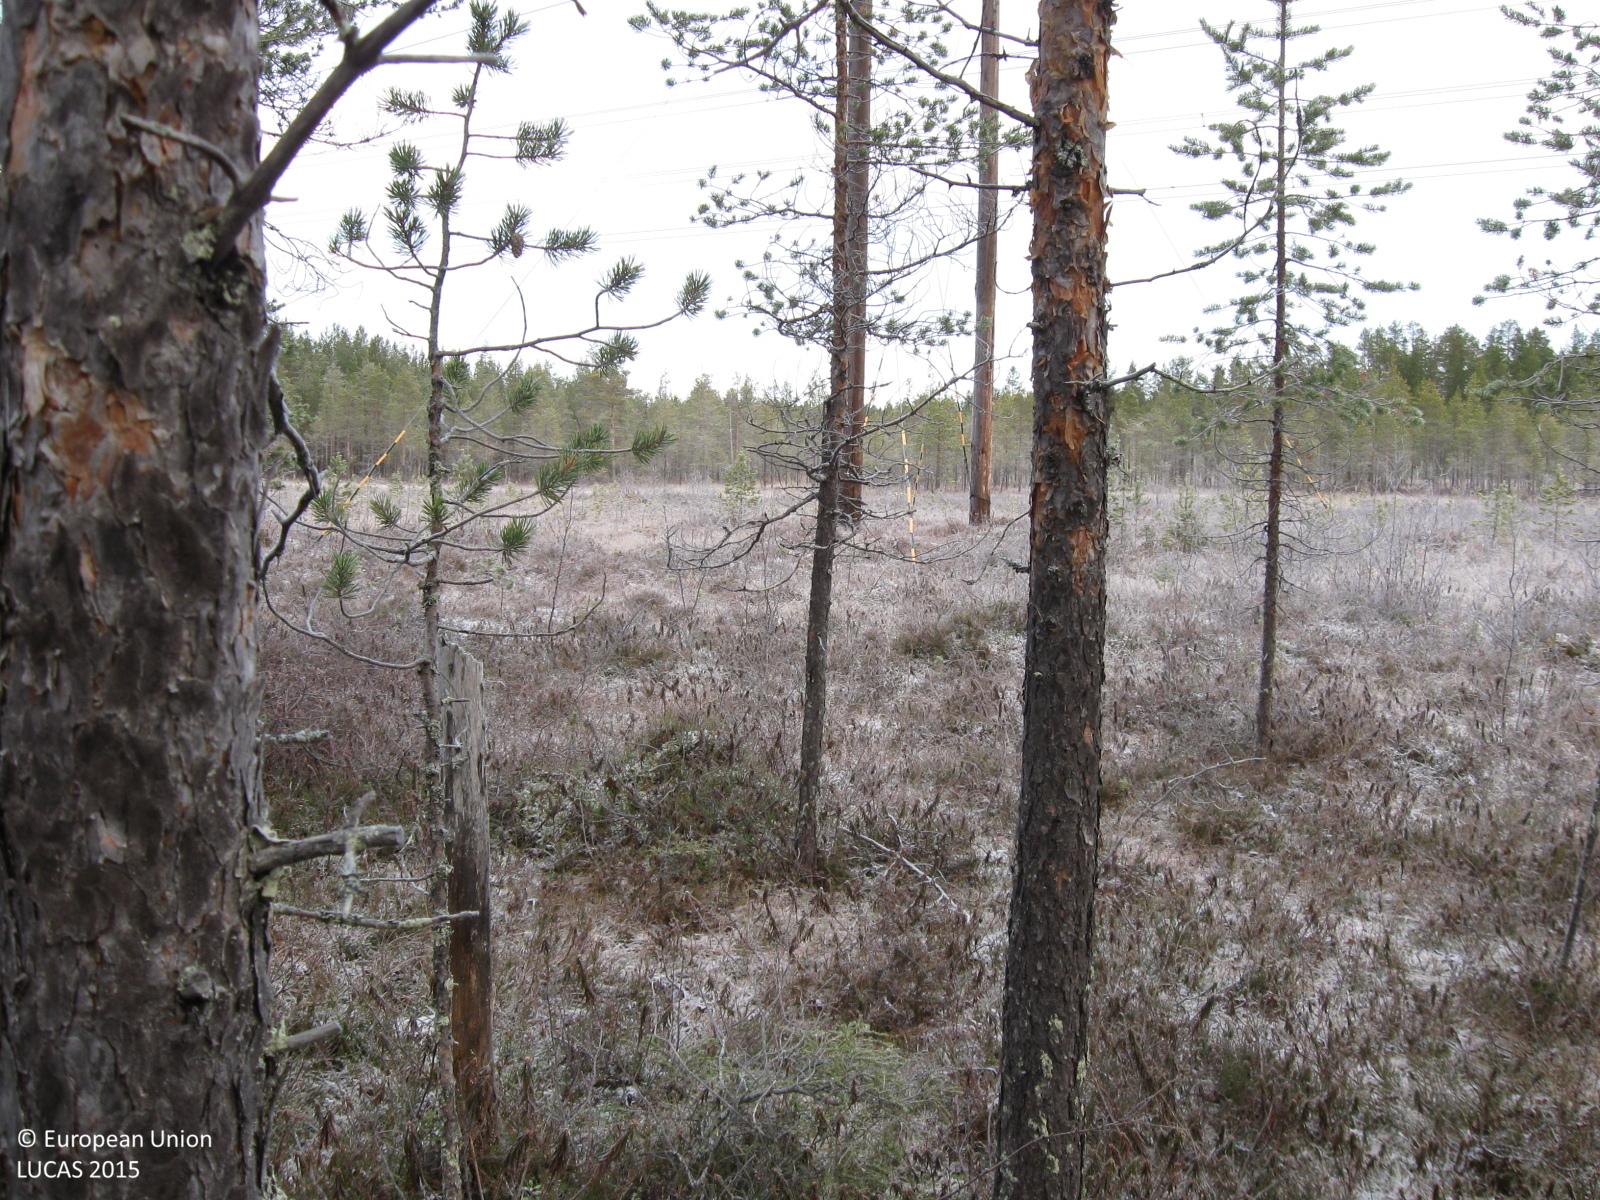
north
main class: Woodland
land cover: Pine dominated coniferous woodland
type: mire and swamp forests
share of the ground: 50 - 75 %
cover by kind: coniferous forest trees 55 %, shrubs 25 %, herbaceous plants 10 %, lichens and mosses 10 %
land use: Forestry
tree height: > 5 m
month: October
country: SE
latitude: 66.1146
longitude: 21.3198
